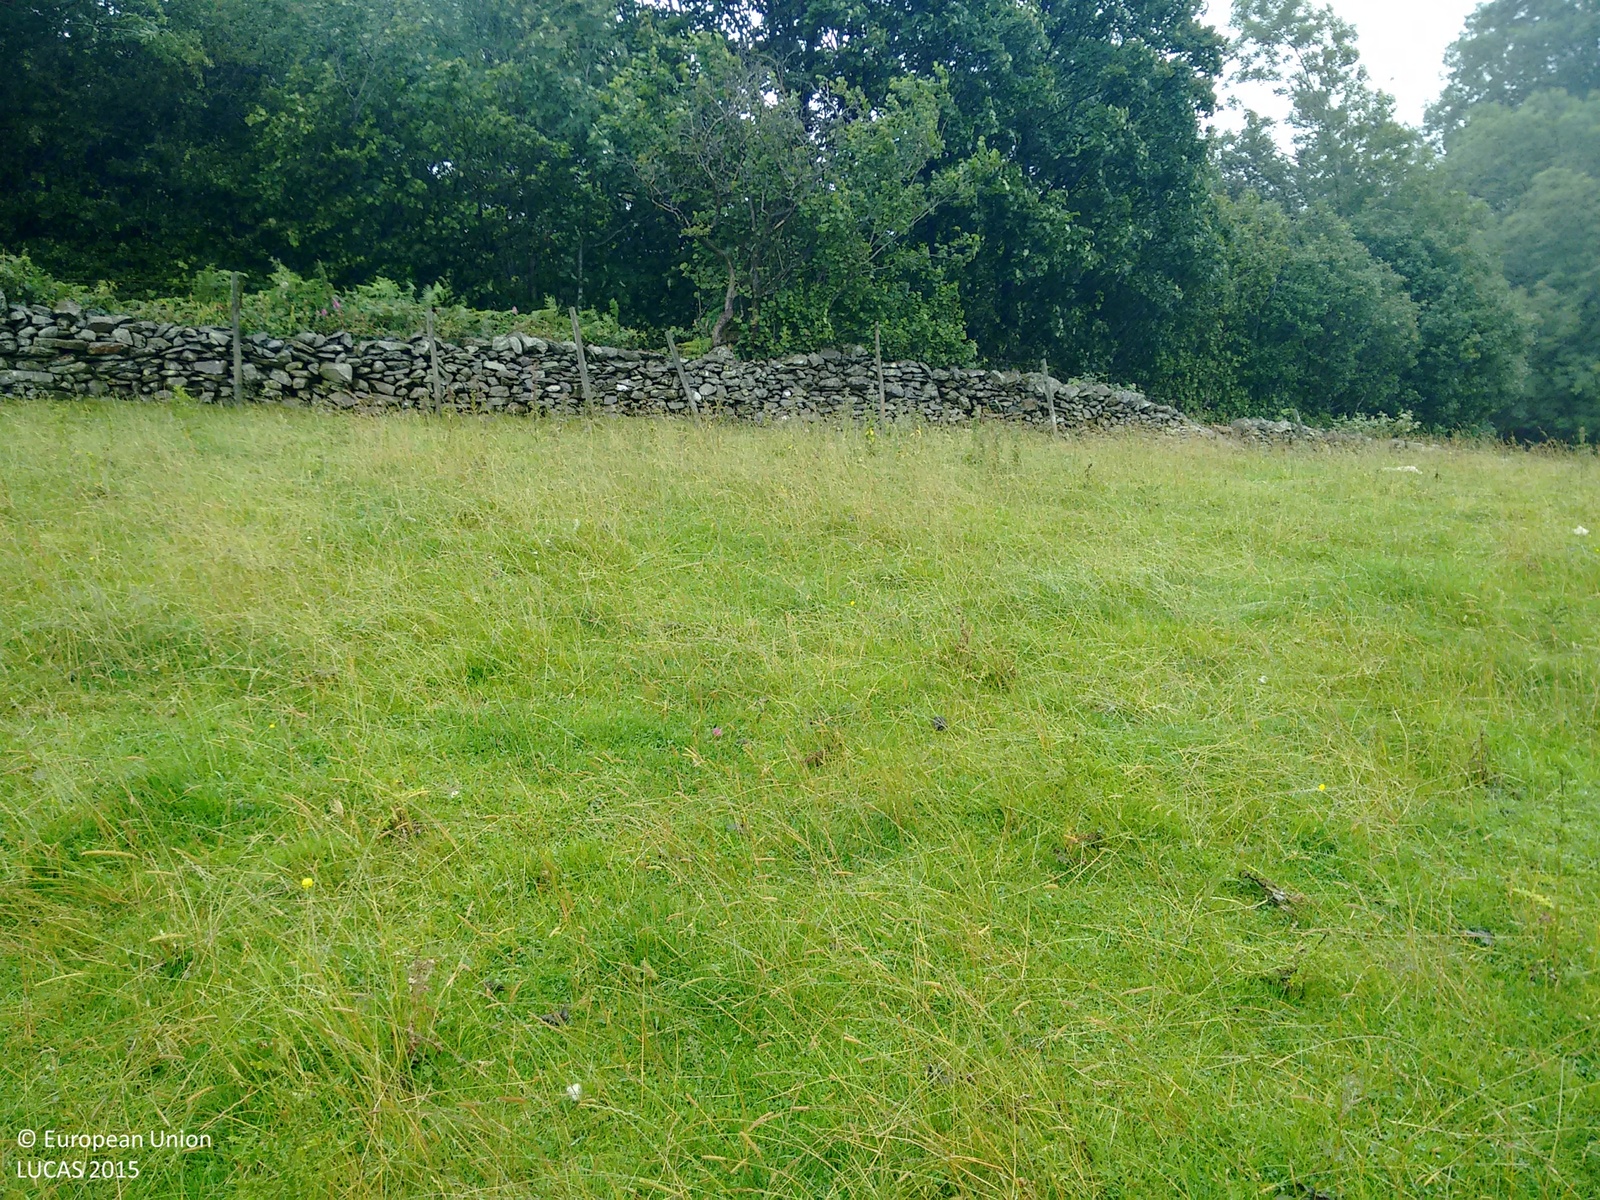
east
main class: Grassland
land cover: Grassland without tree/shrub cover
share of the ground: > 75 %
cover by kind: herbaceous plants 100 %
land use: Agriculture (excluding fallow land and kitchen gardens)
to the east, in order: Grassland without tree/shrub cover; Fences; Dry stone walls; Grass margins; Tracks; Broadleaved woodland; Grassland without tree/shrub cover; Broadleaved woodland; Fences; Tracks; Fences; Grassland without tree/shrub cover; Fences; Lines of trees; Ditches and canals; Grassland without tree/shrub cover; Dry stone walls; Grass margins; Lines of trees; Grassland without tree/shrub cover; Lines of trees; Shrubland without tree cover
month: August
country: GB
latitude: 54.3894
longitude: -2.6795
